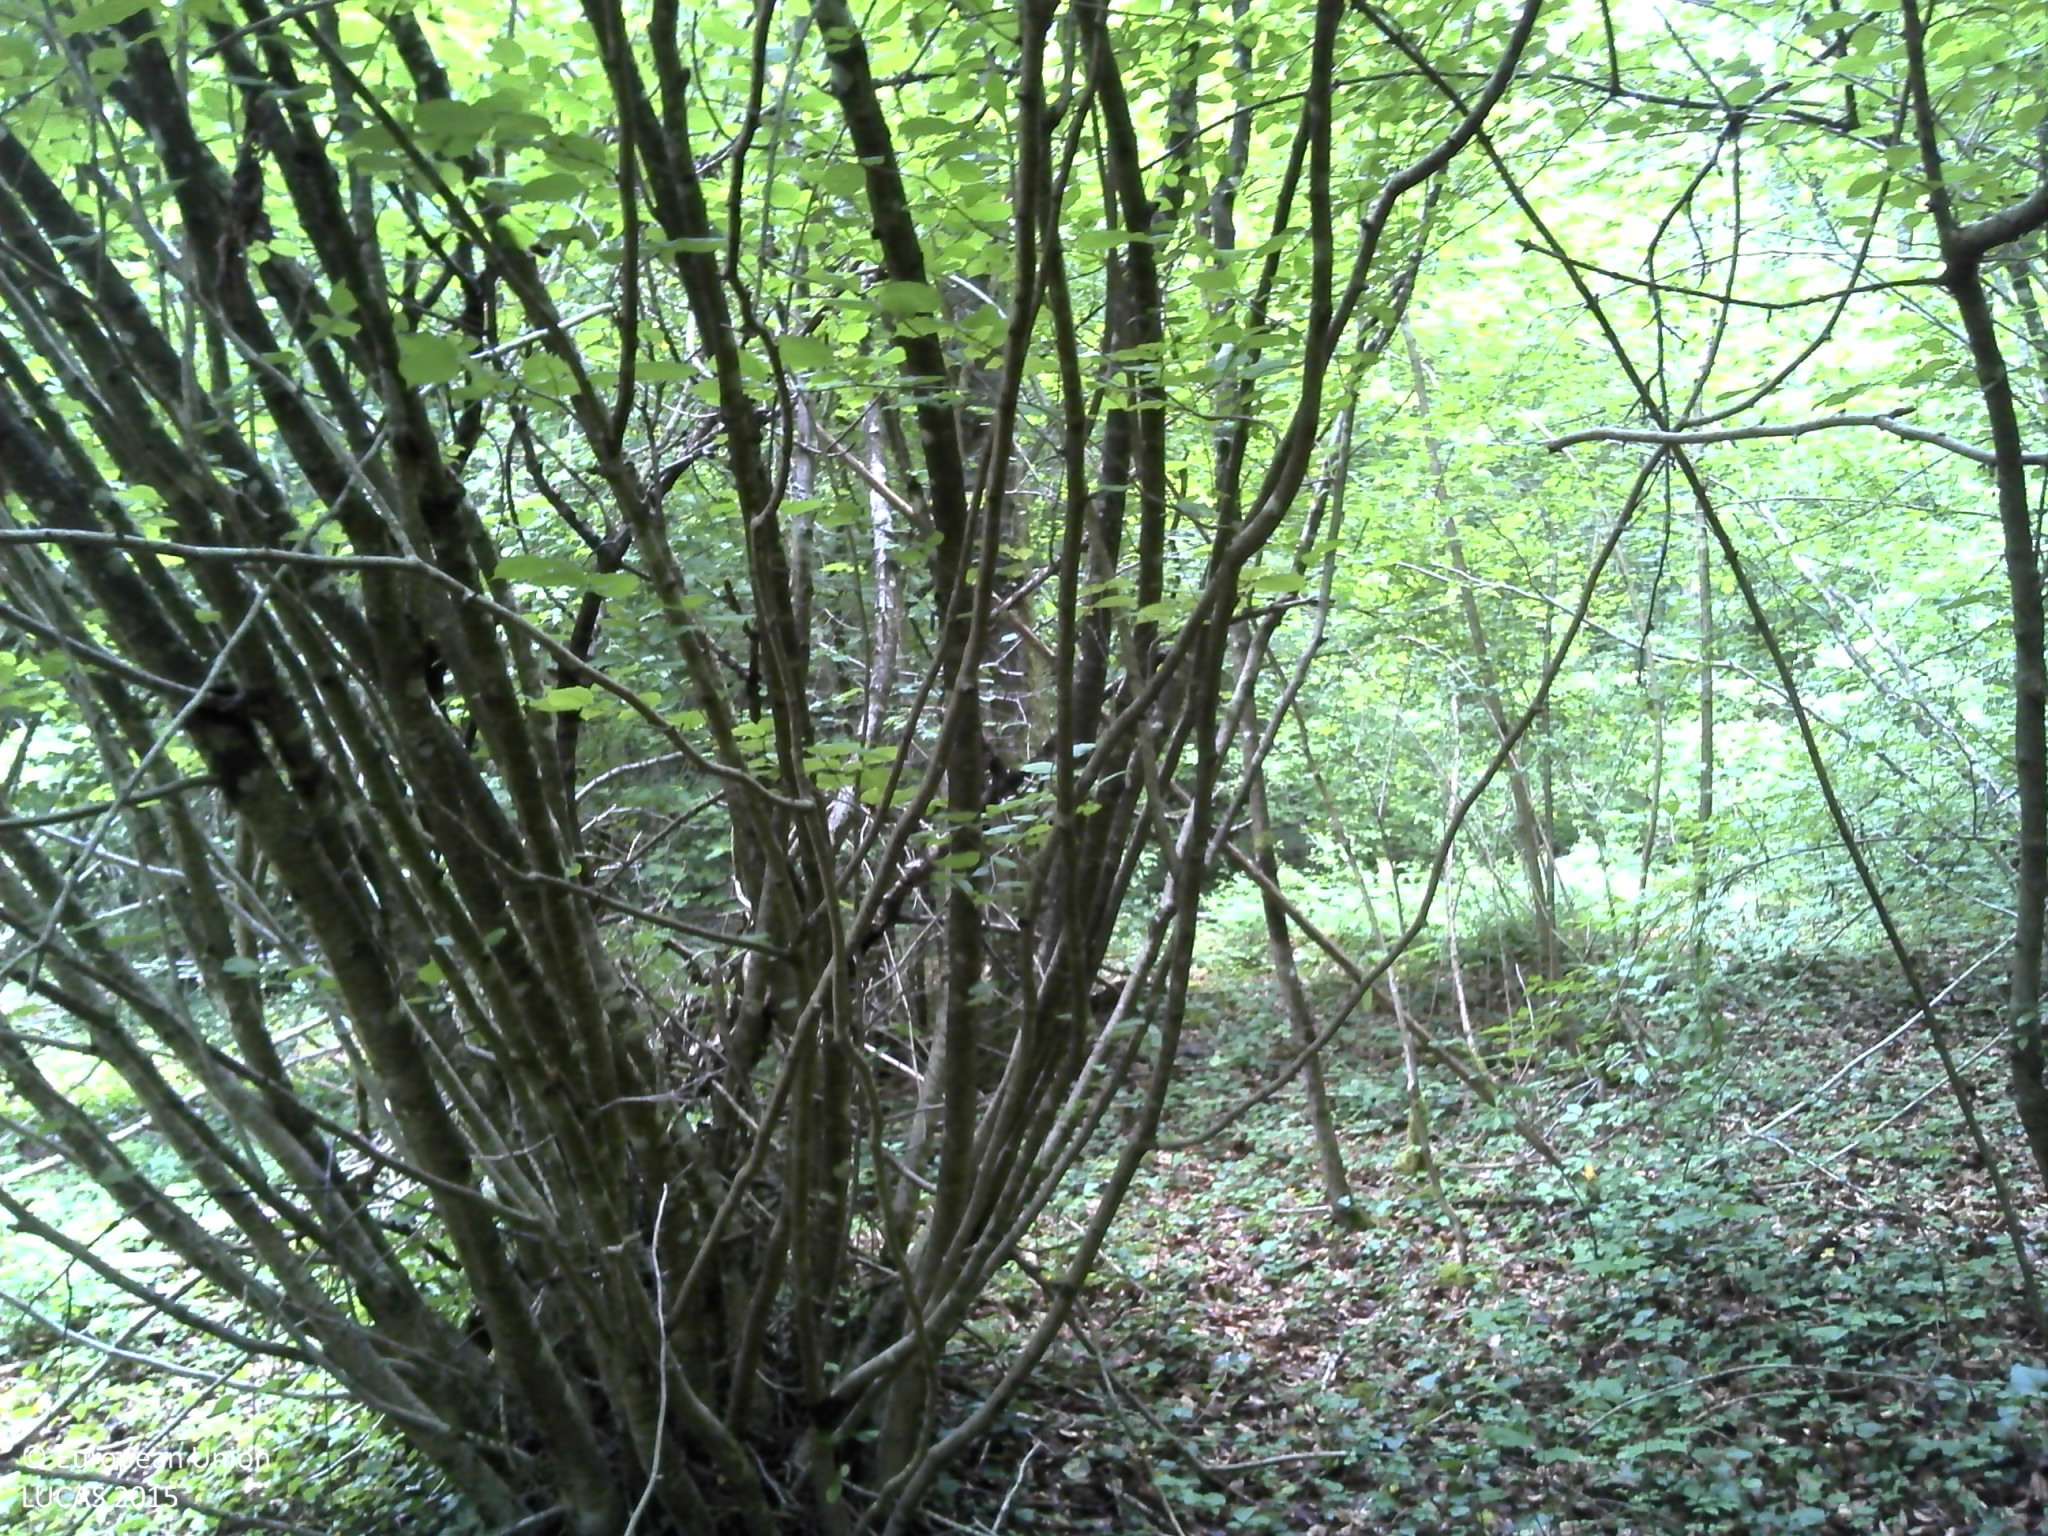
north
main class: Woodland
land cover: Broadleaved woodland
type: beech forest
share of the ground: 50 - 75 %
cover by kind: broadleaved forest trees 70 %, herbaceous plants 20 %, consolidated bare surface 10 %
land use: Forestry
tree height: > 5 m
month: June
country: FR
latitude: 49.6321
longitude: 4.7772
